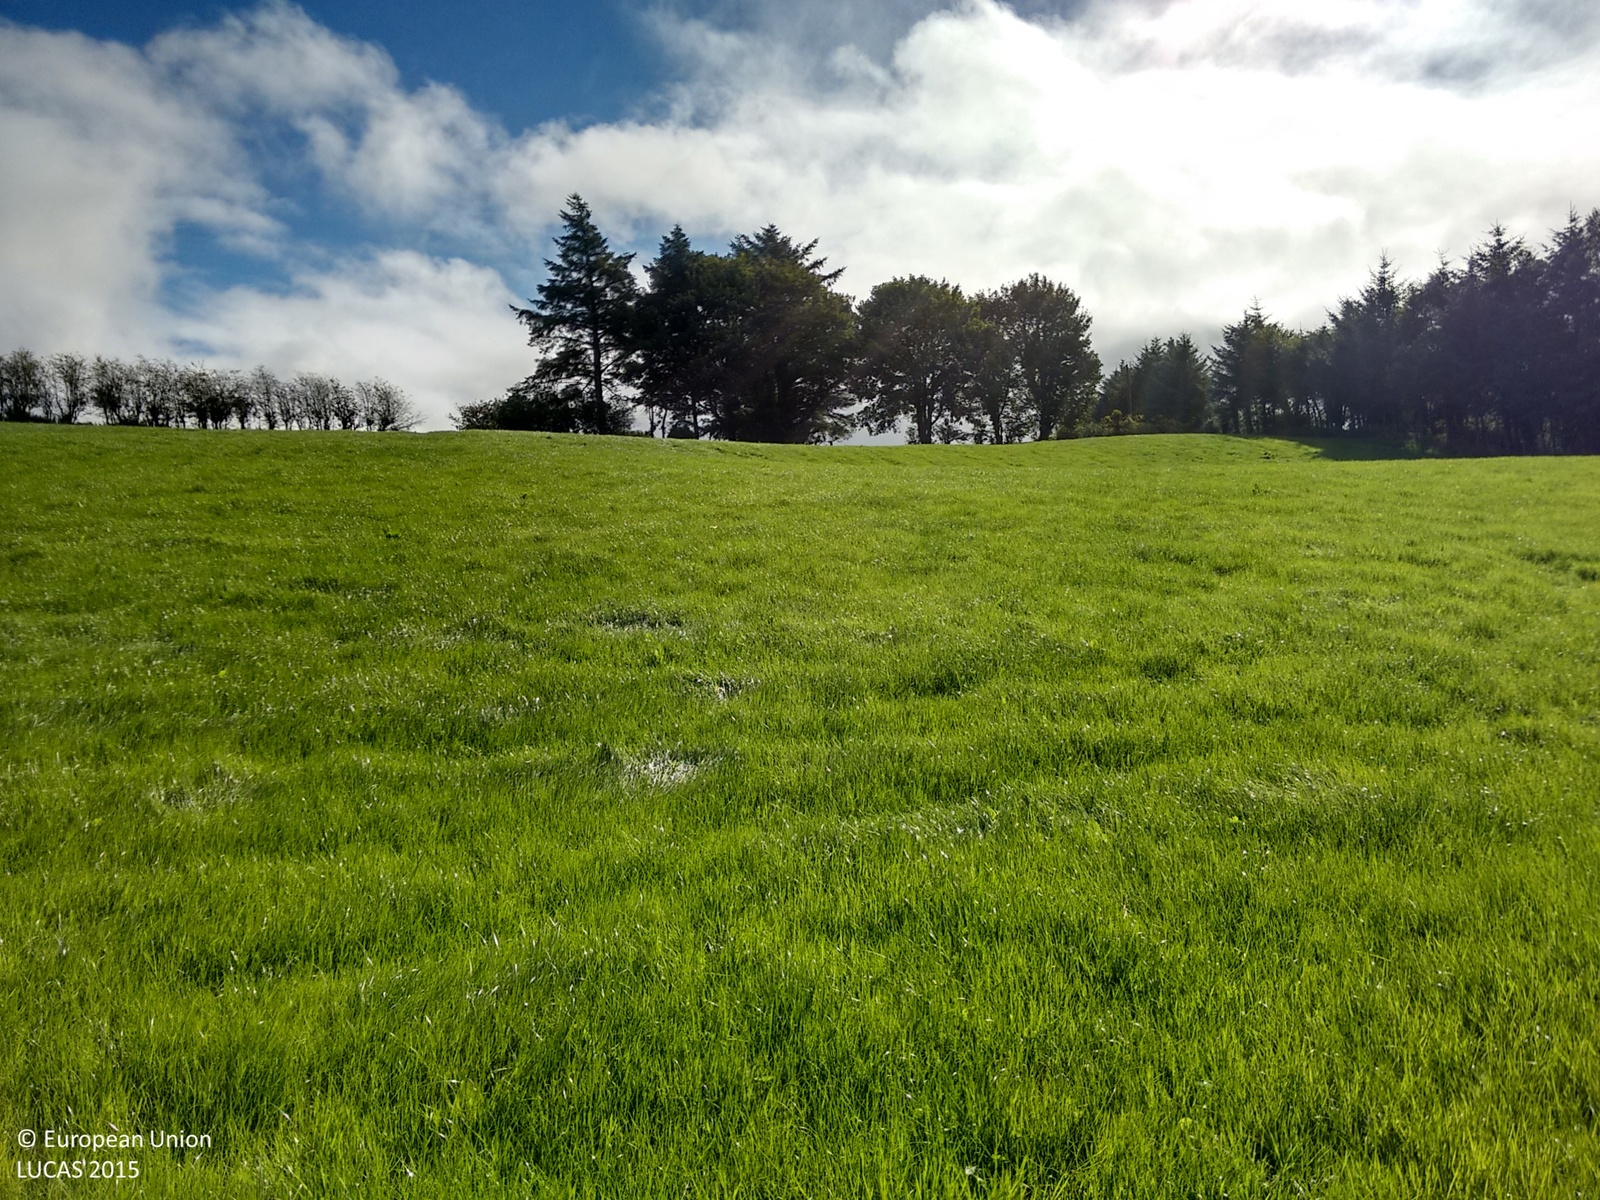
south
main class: Woodland
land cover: Broadleaved woodland
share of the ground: > 75 %
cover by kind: broadleaved forest trees 75 %, herbaceous plants 25 %
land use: Agriculture (excluding fallow land and kitchen gardens)
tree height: < 5 m
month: September
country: IE
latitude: 53.7443
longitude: -8.7778
